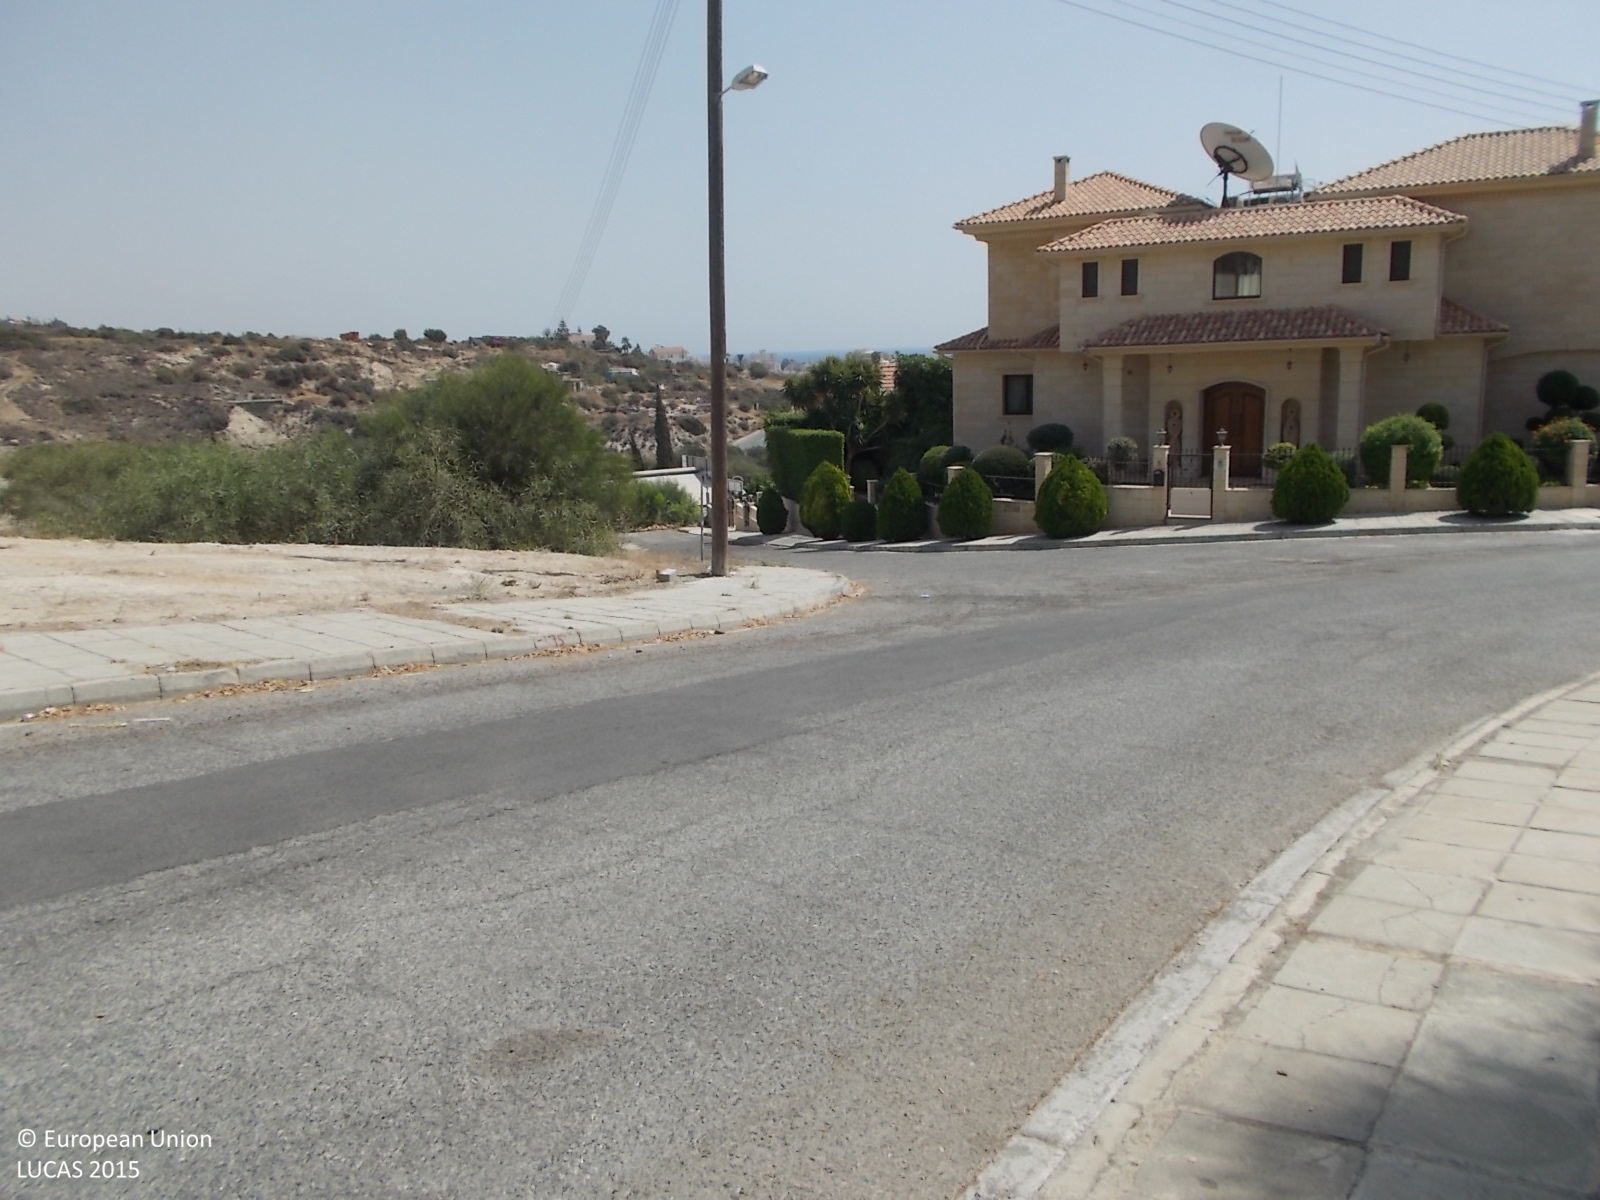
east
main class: Woodland
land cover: Broadleaved woodland
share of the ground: 50 - 75 %
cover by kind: broadleaved forest trees 70 %, unconsolidated bare surface 20 %, consolidated bare surface 10 %
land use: Residential
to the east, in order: Broadleaved woodland; Paved roads, cycling and walking lanes; Other bare soil; Shrubland without tree cover; Artificial constructions in urban areas; Other bare soil; Shrubland without tree cover
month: April
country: CY
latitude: 34.7101
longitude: 33.1078
